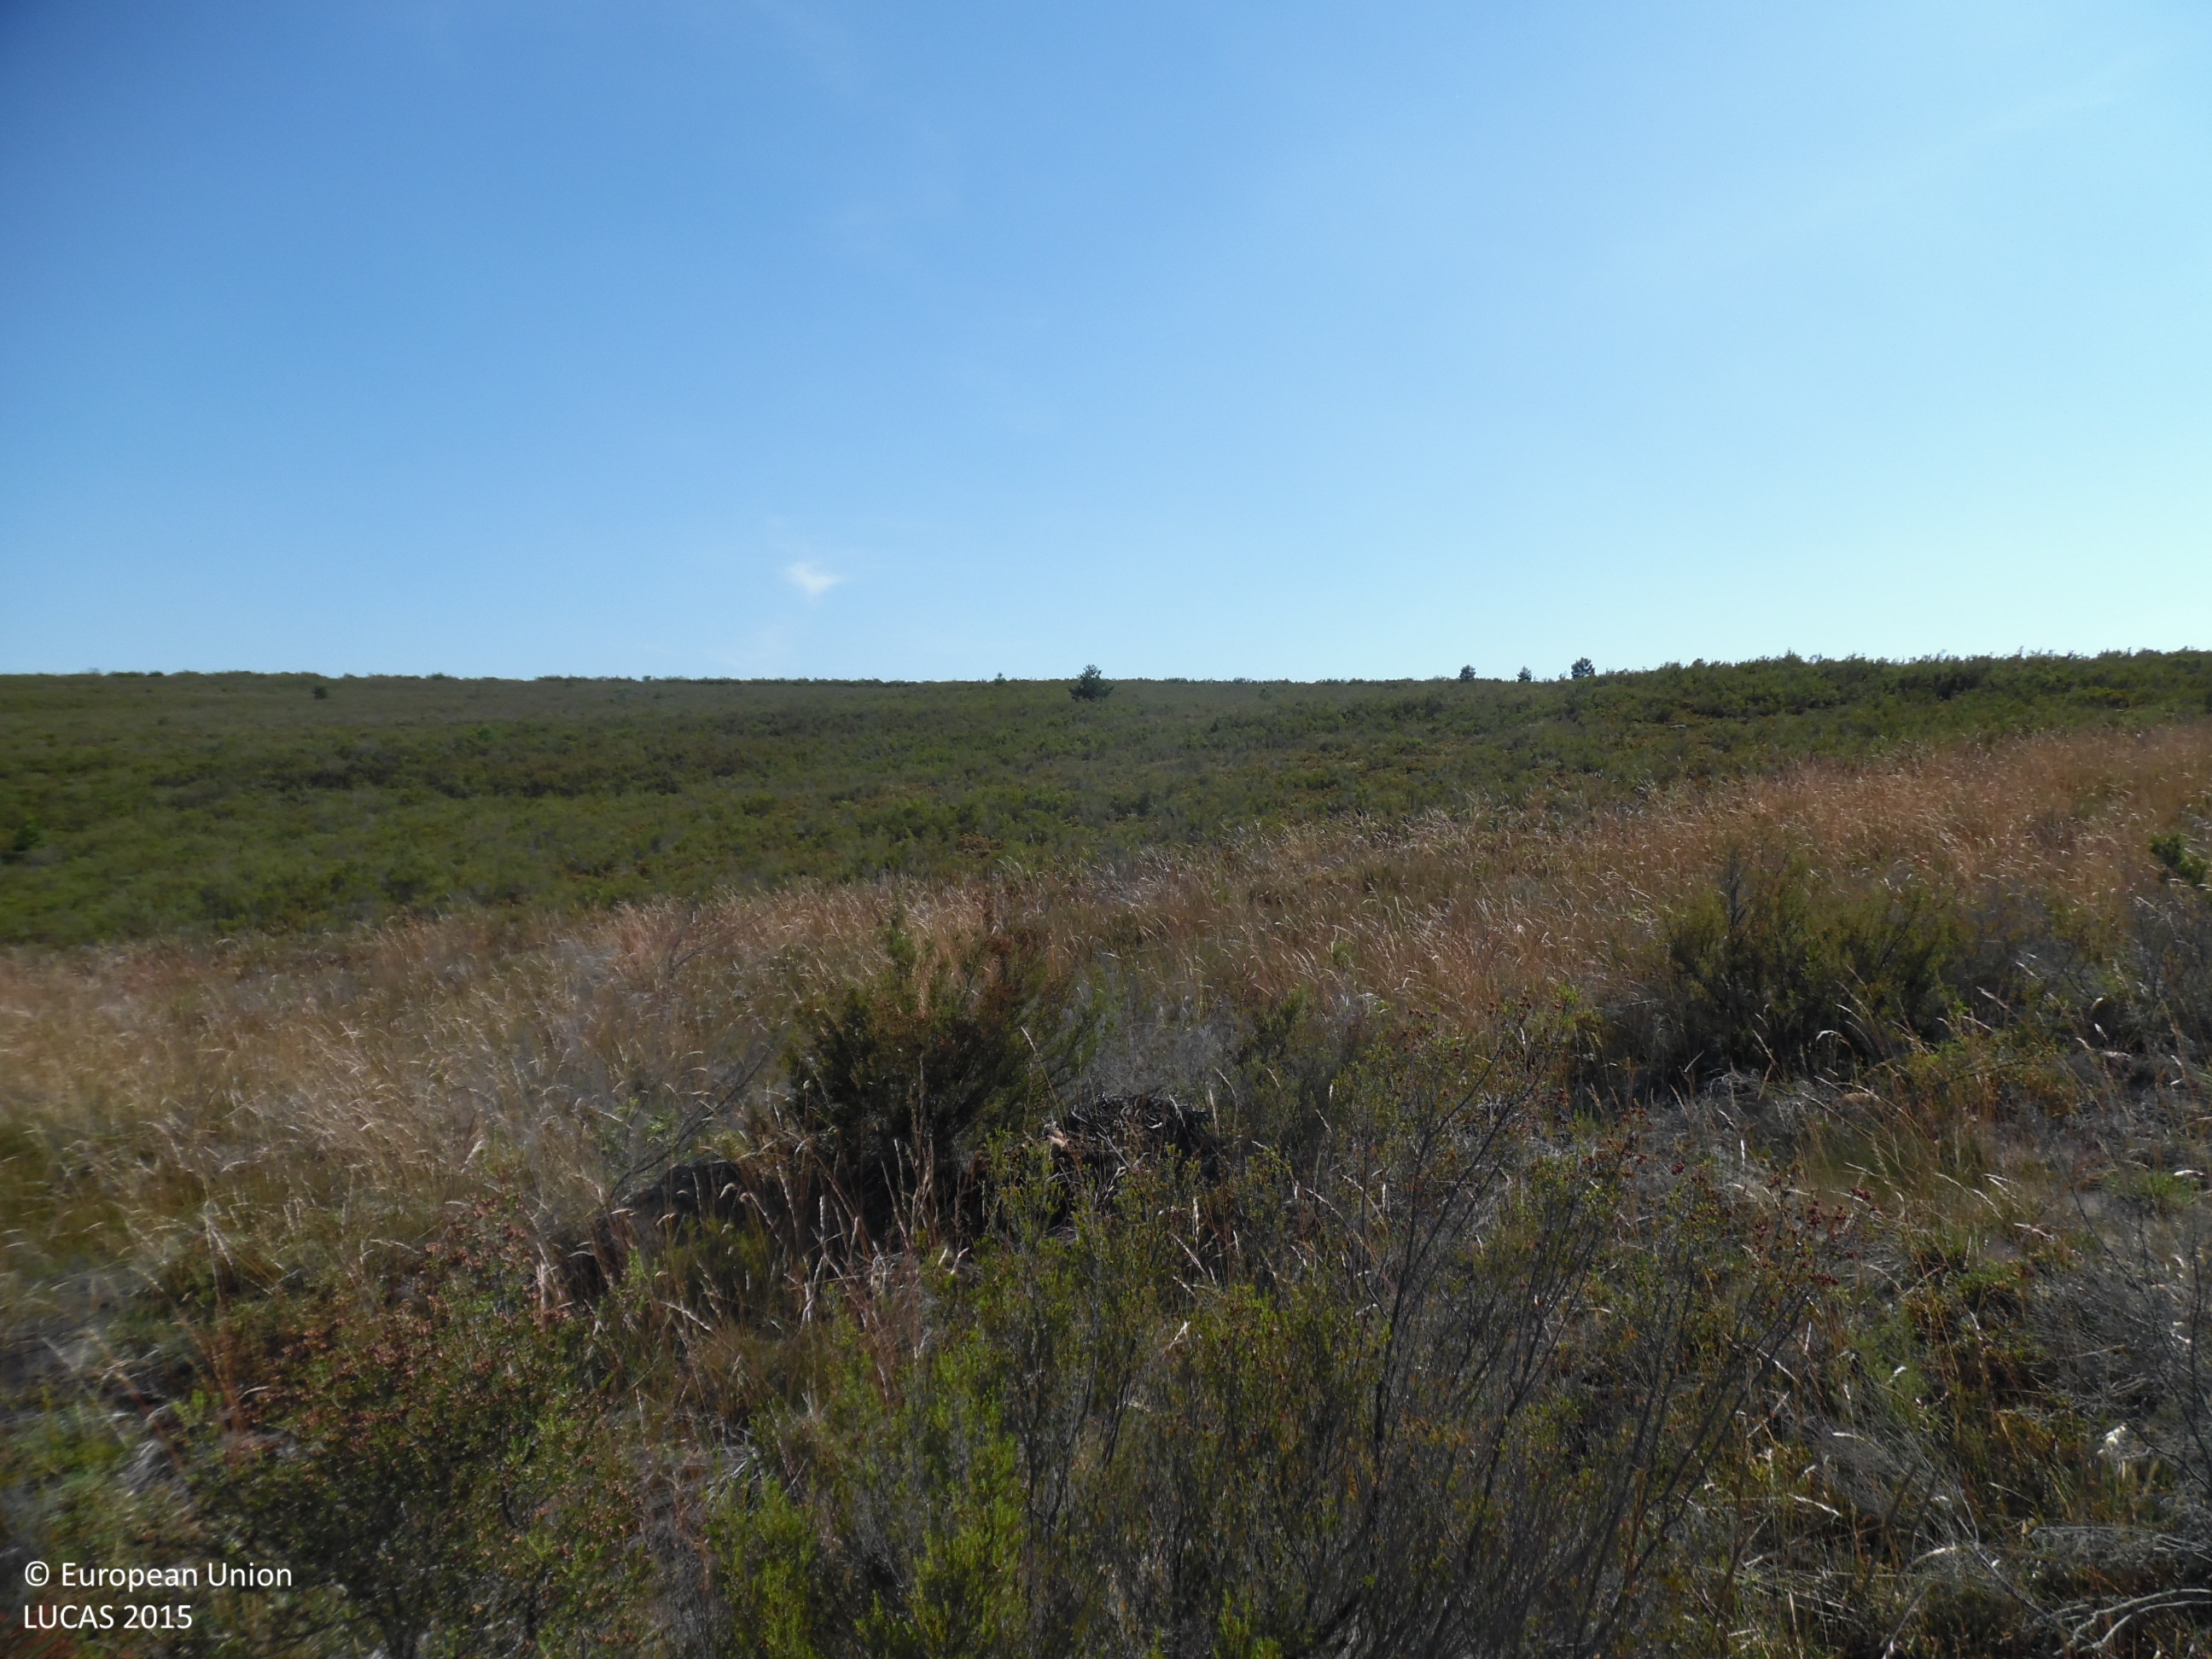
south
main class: Shrubland
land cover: Shrubland without tree cover
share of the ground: > 75 %
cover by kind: shrubs 100 %
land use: Forestry
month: June
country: ES
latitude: 42.7249
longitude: -5.6966
